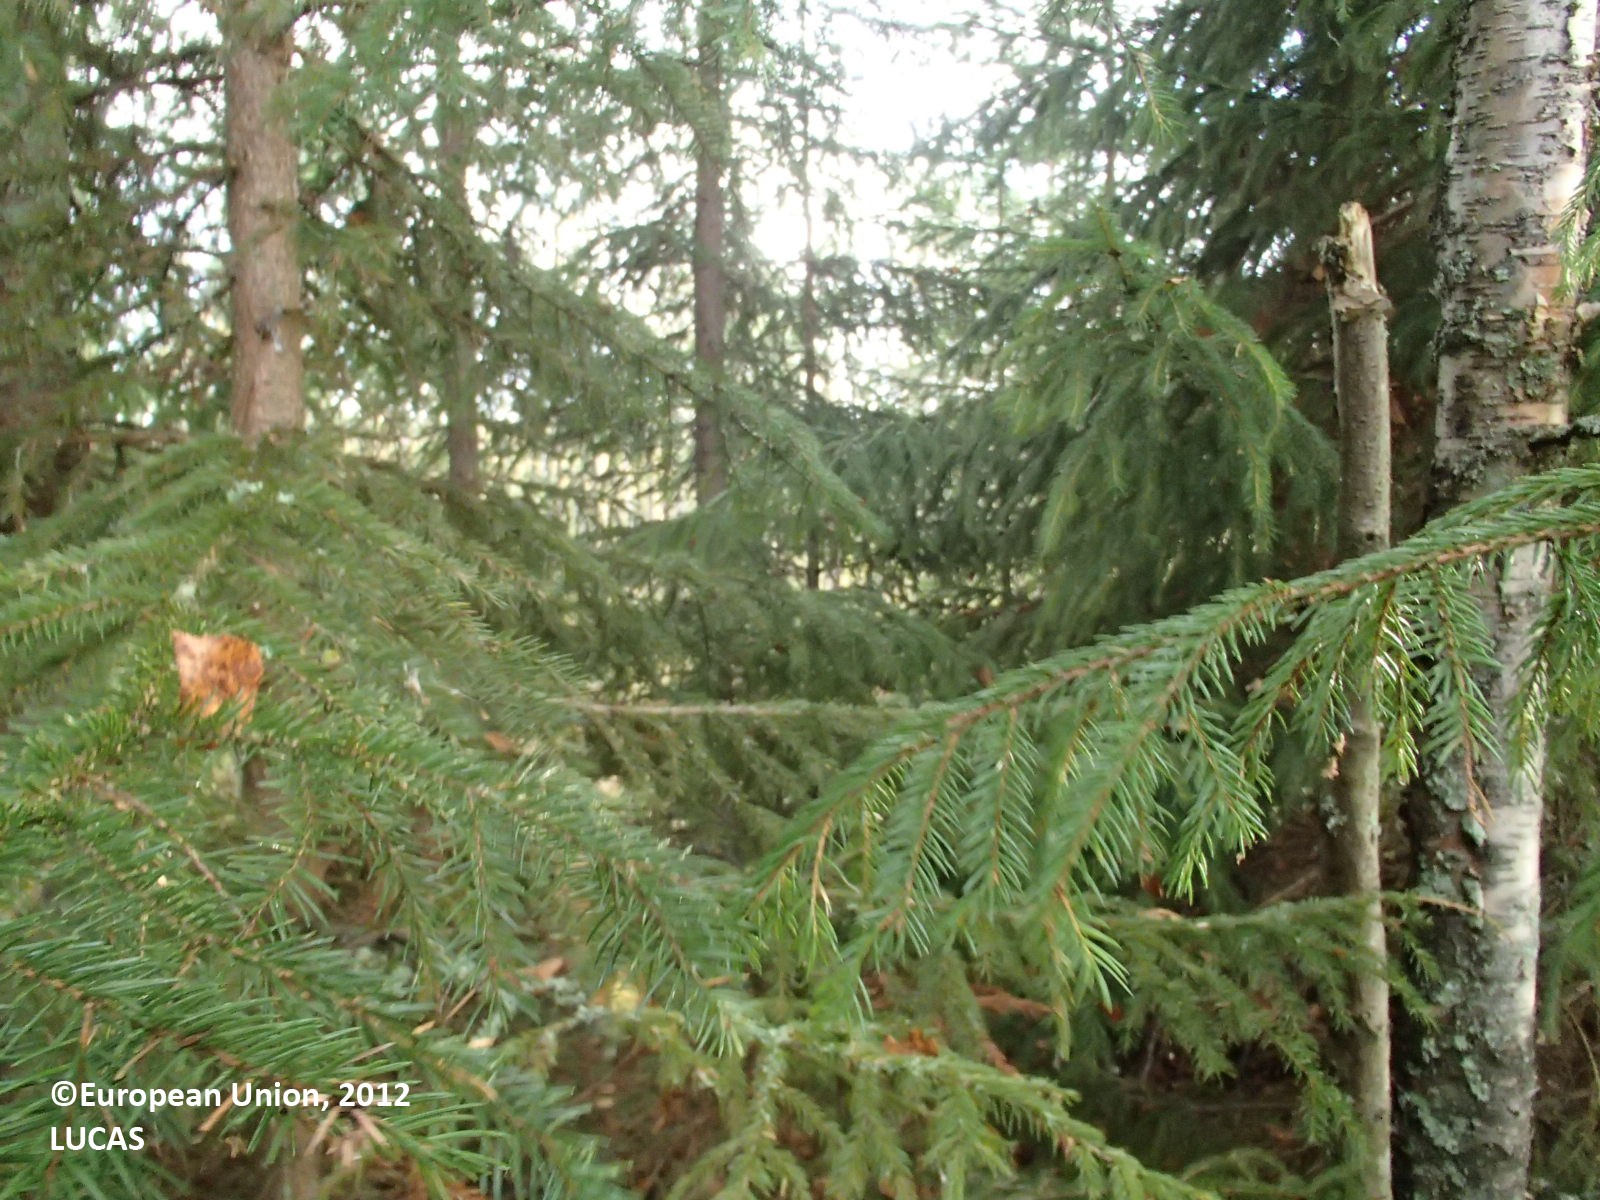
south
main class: Woodland
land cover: Spruce dominated mixed woodland
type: boreal forest
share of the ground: > 75 %
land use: Forestry
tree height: > 5 m
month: September
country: FI
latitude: 63.3448
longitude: 27.7682
